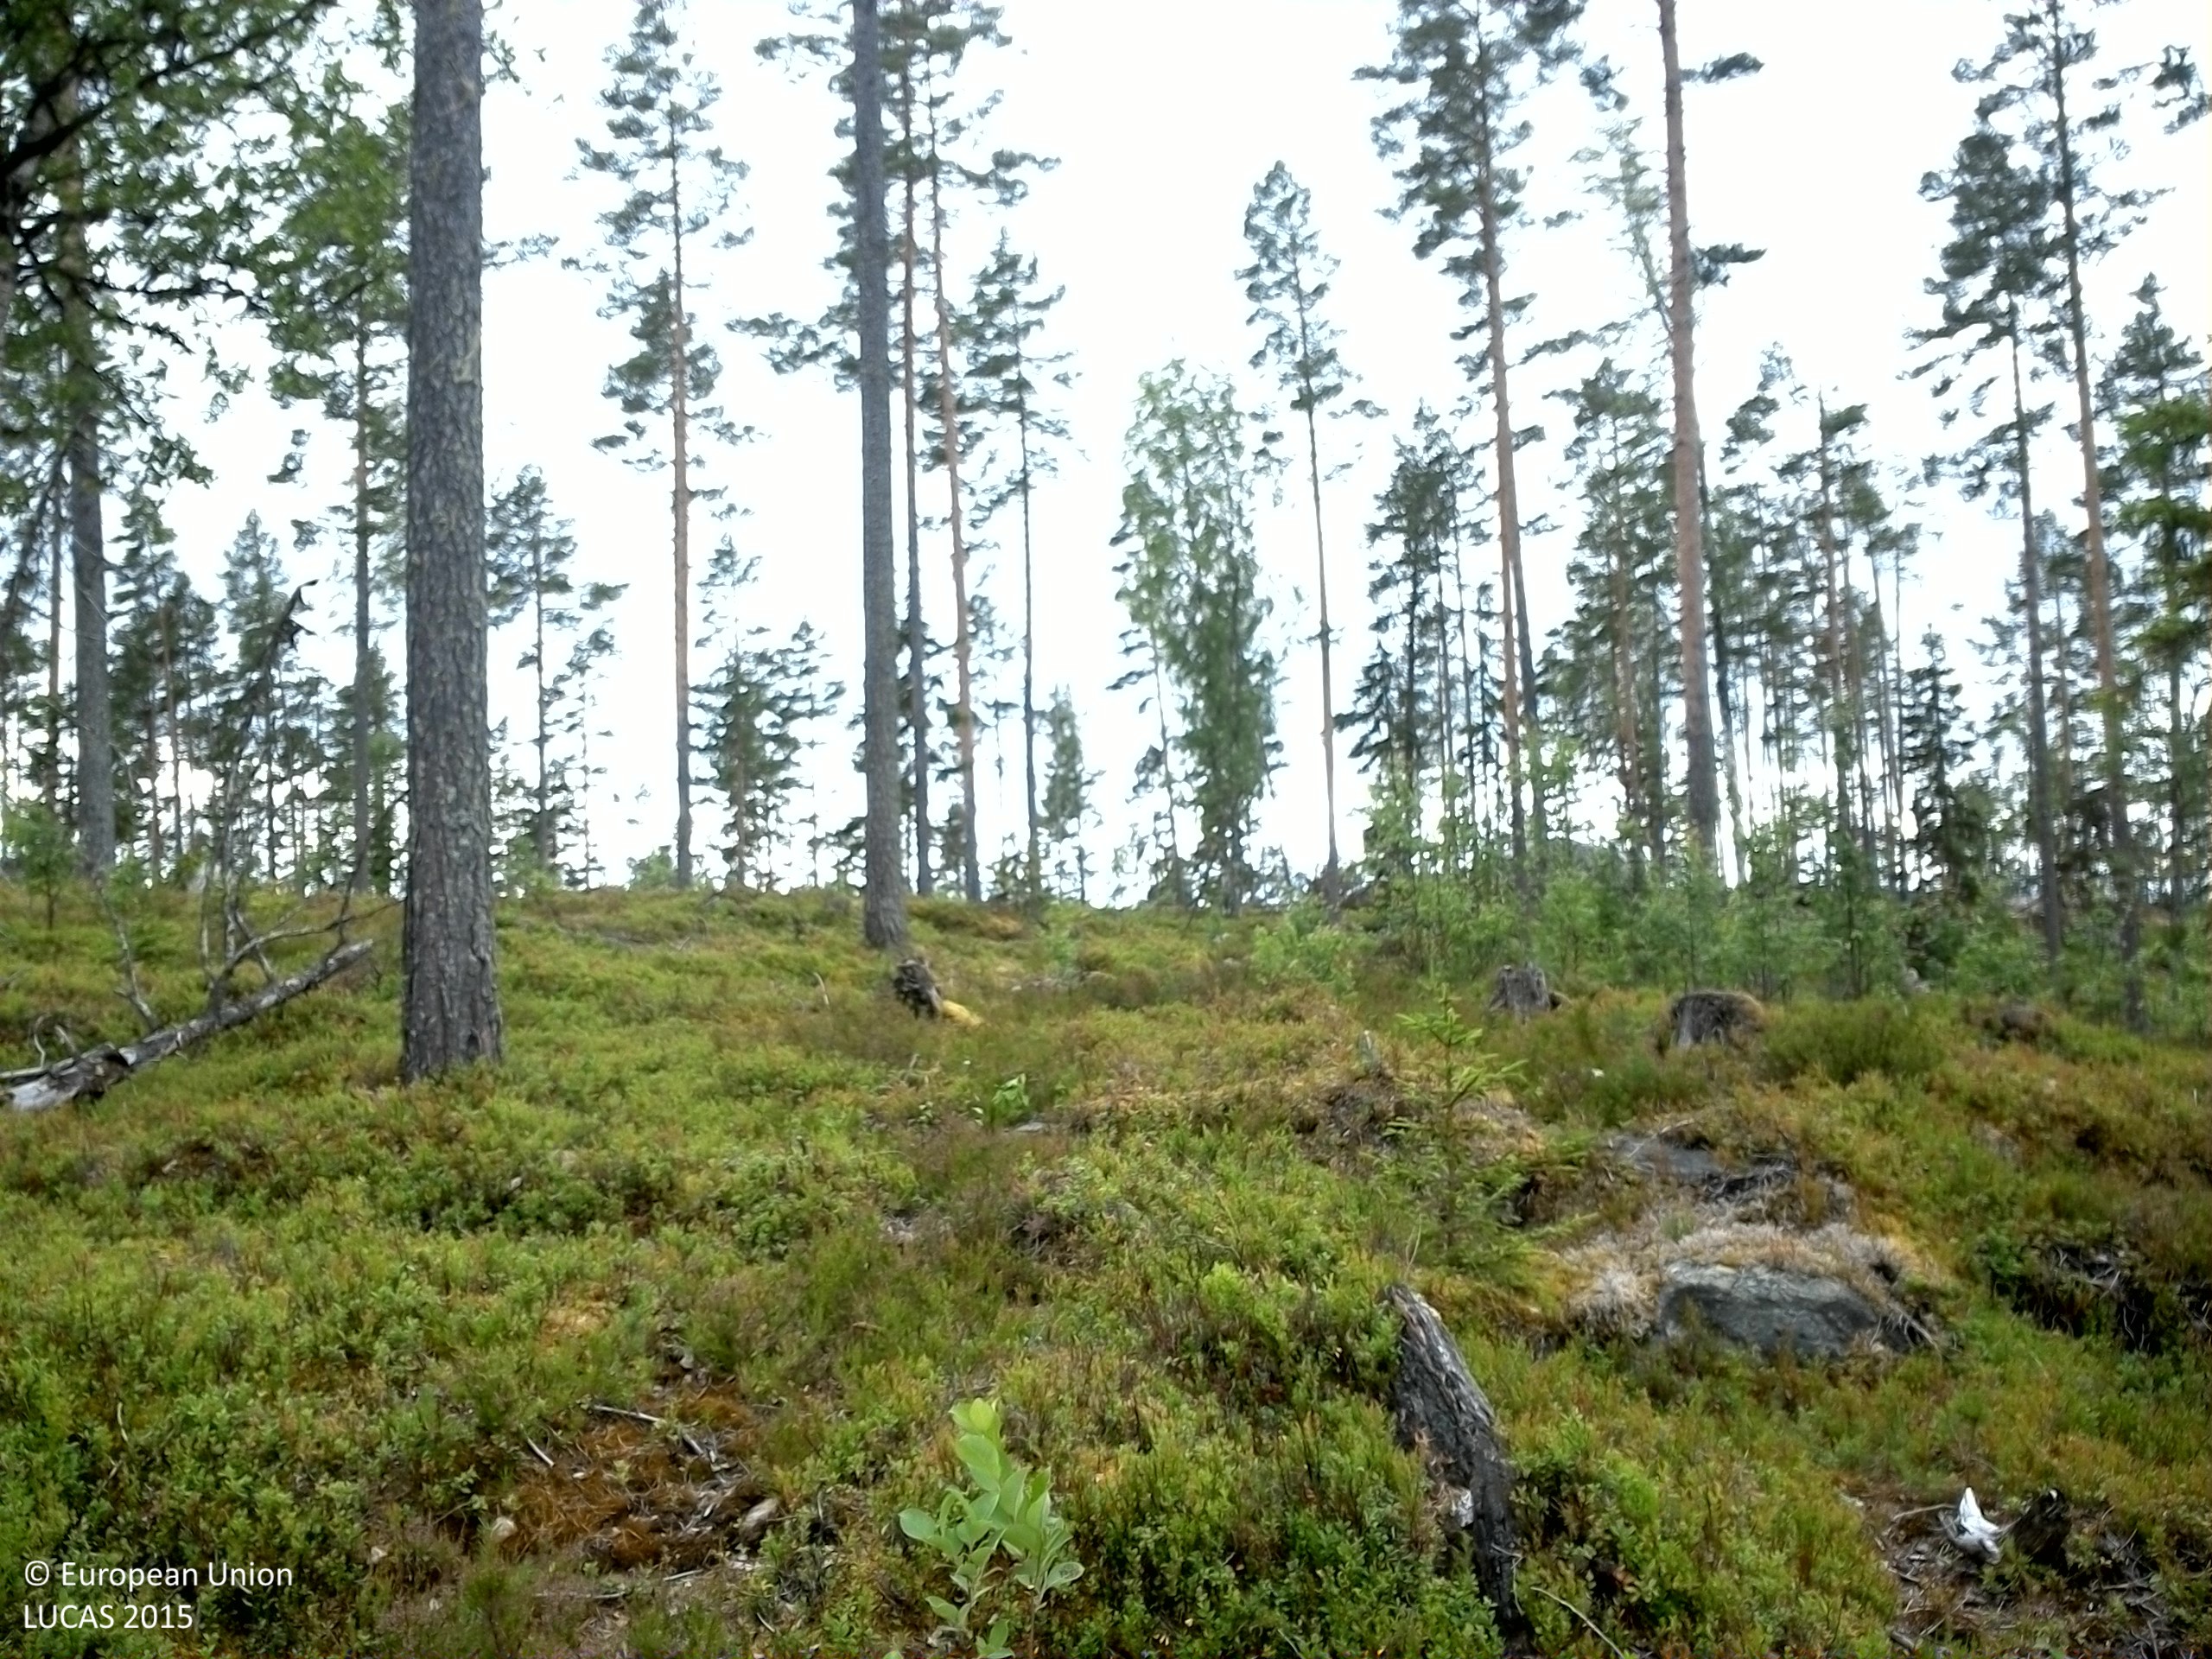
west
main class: Woodland
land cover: Pine dominated mixed woodland
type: boreal forest
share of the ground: 25 - 50 %
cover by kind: shrubs 40 %, coniferous forest trees 25 %, lichens and mosses 15 %, broadleaved forest trees 10 %, herbaceous plants 10 %
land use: Forestry
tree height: > 5 m
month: July
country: SE
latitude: 62.7983
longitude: 16.8995
